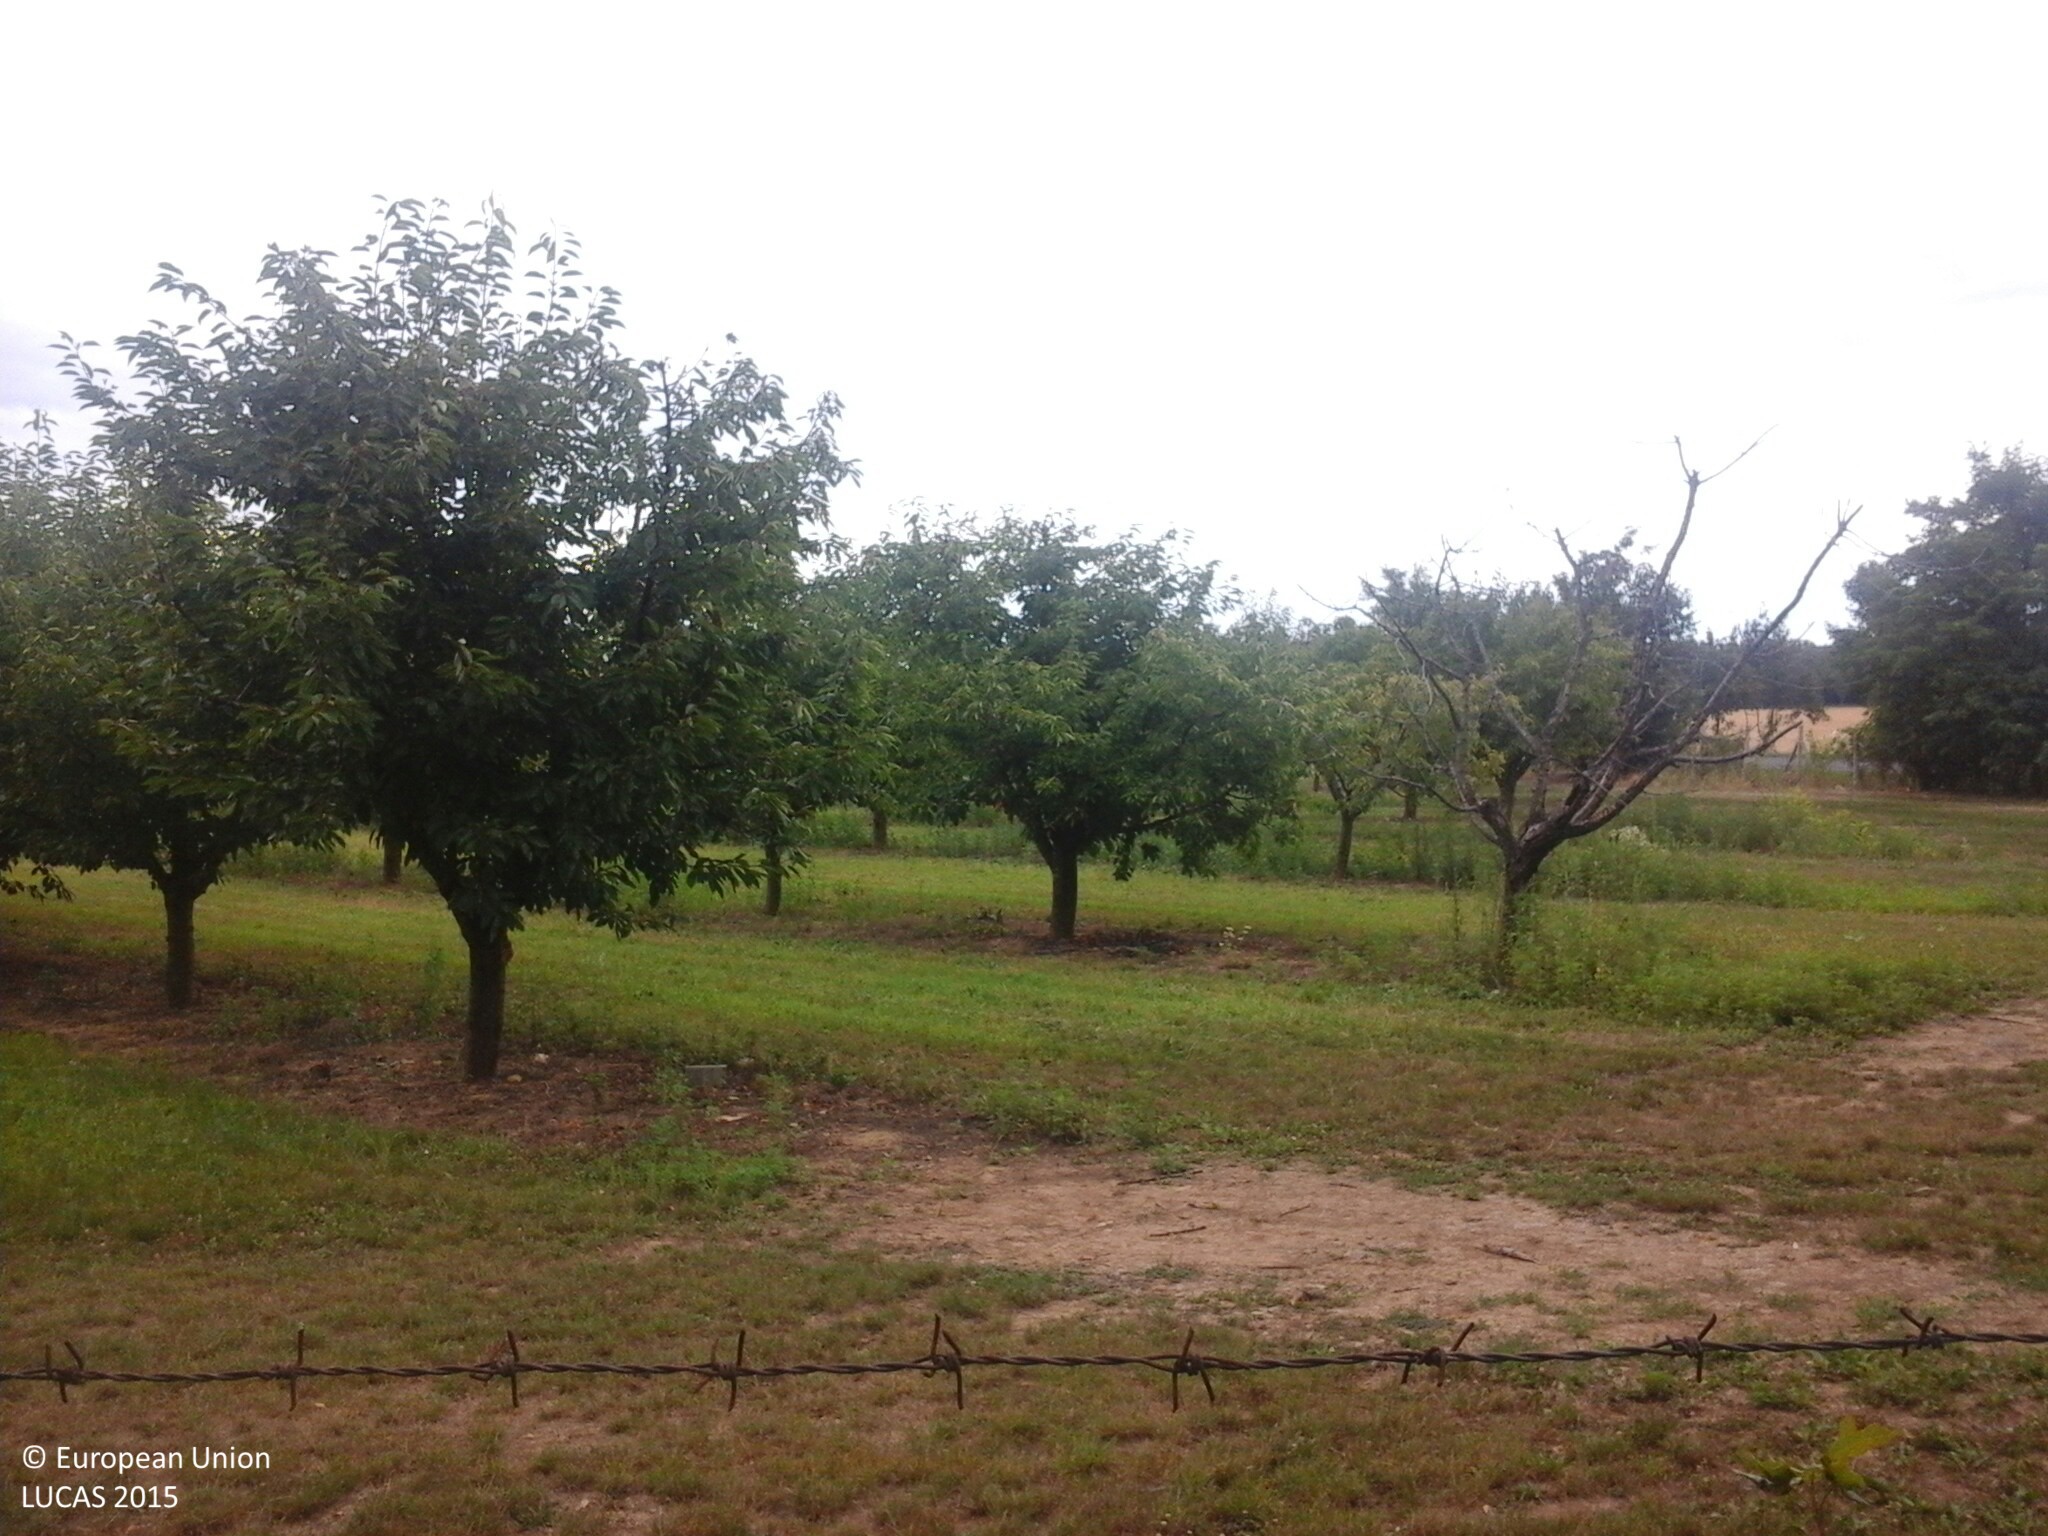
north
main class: Cropland
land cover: Cherry fruit
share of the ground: 50 - 75 %
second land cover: Grassland without tree/shrub cover
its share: 50 - 75 %
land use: Agriculture (excluding fallow land and kitchen gardens)
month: July
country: HU
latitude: 47.0522
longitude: 17.9204
